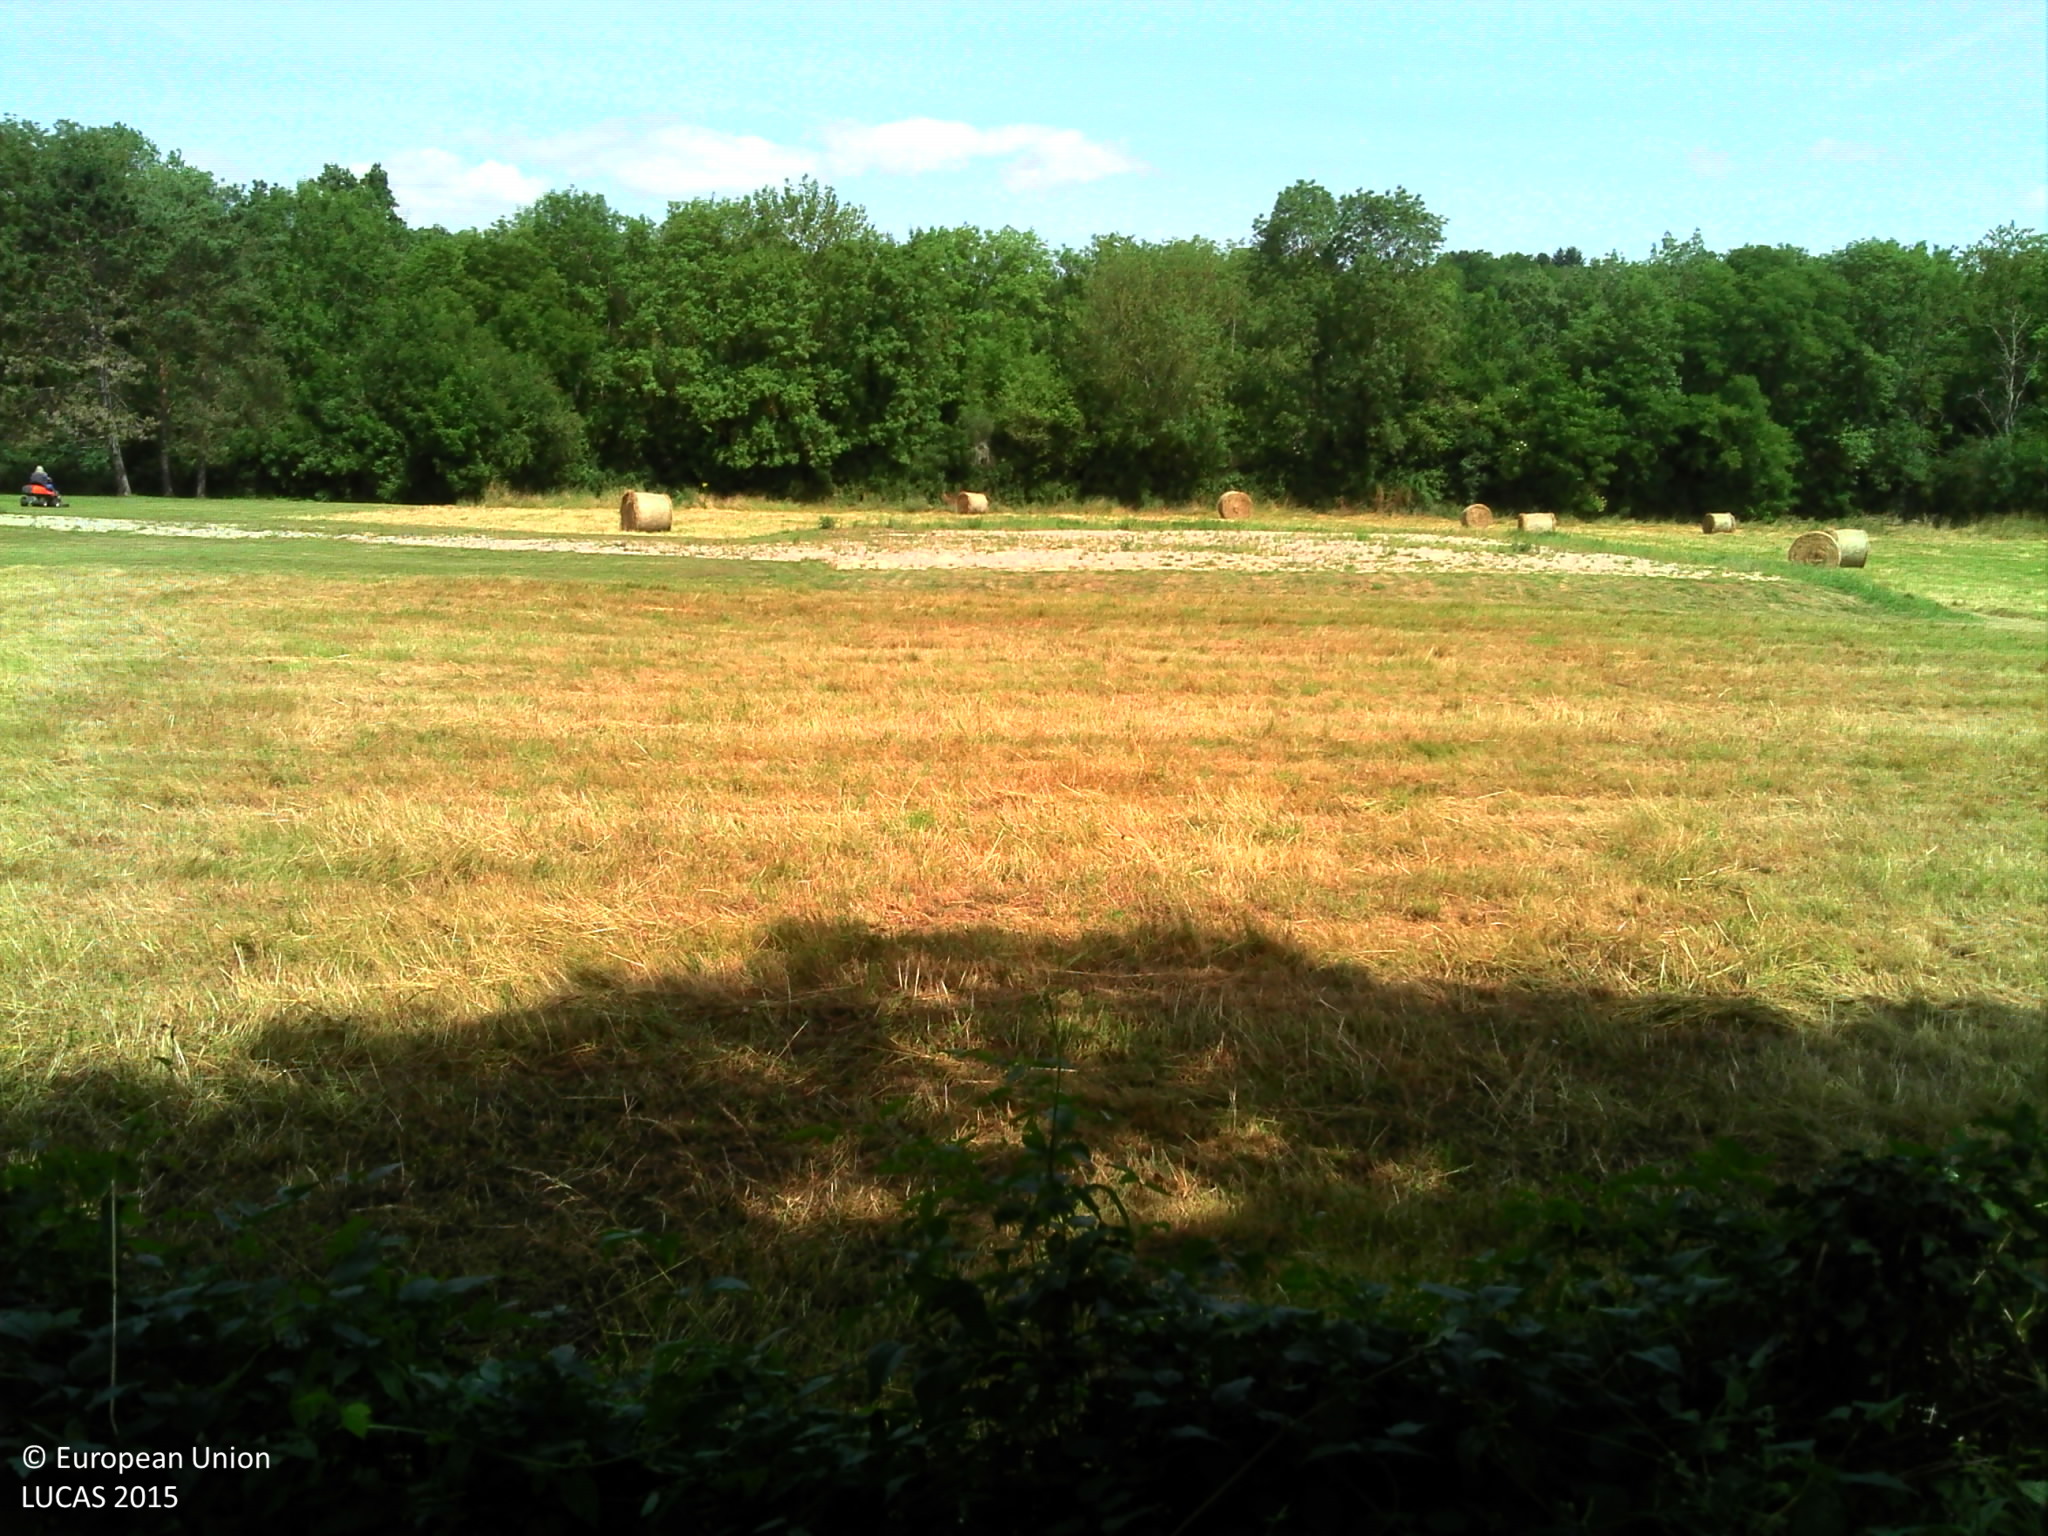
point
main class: Grassland
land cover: Grassland without tree/shrub cover
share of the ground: > 75 %
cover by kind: herbaceous plants 100 %
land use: Community services
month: June
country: FR
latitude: 47.4545
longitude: 3.5104
